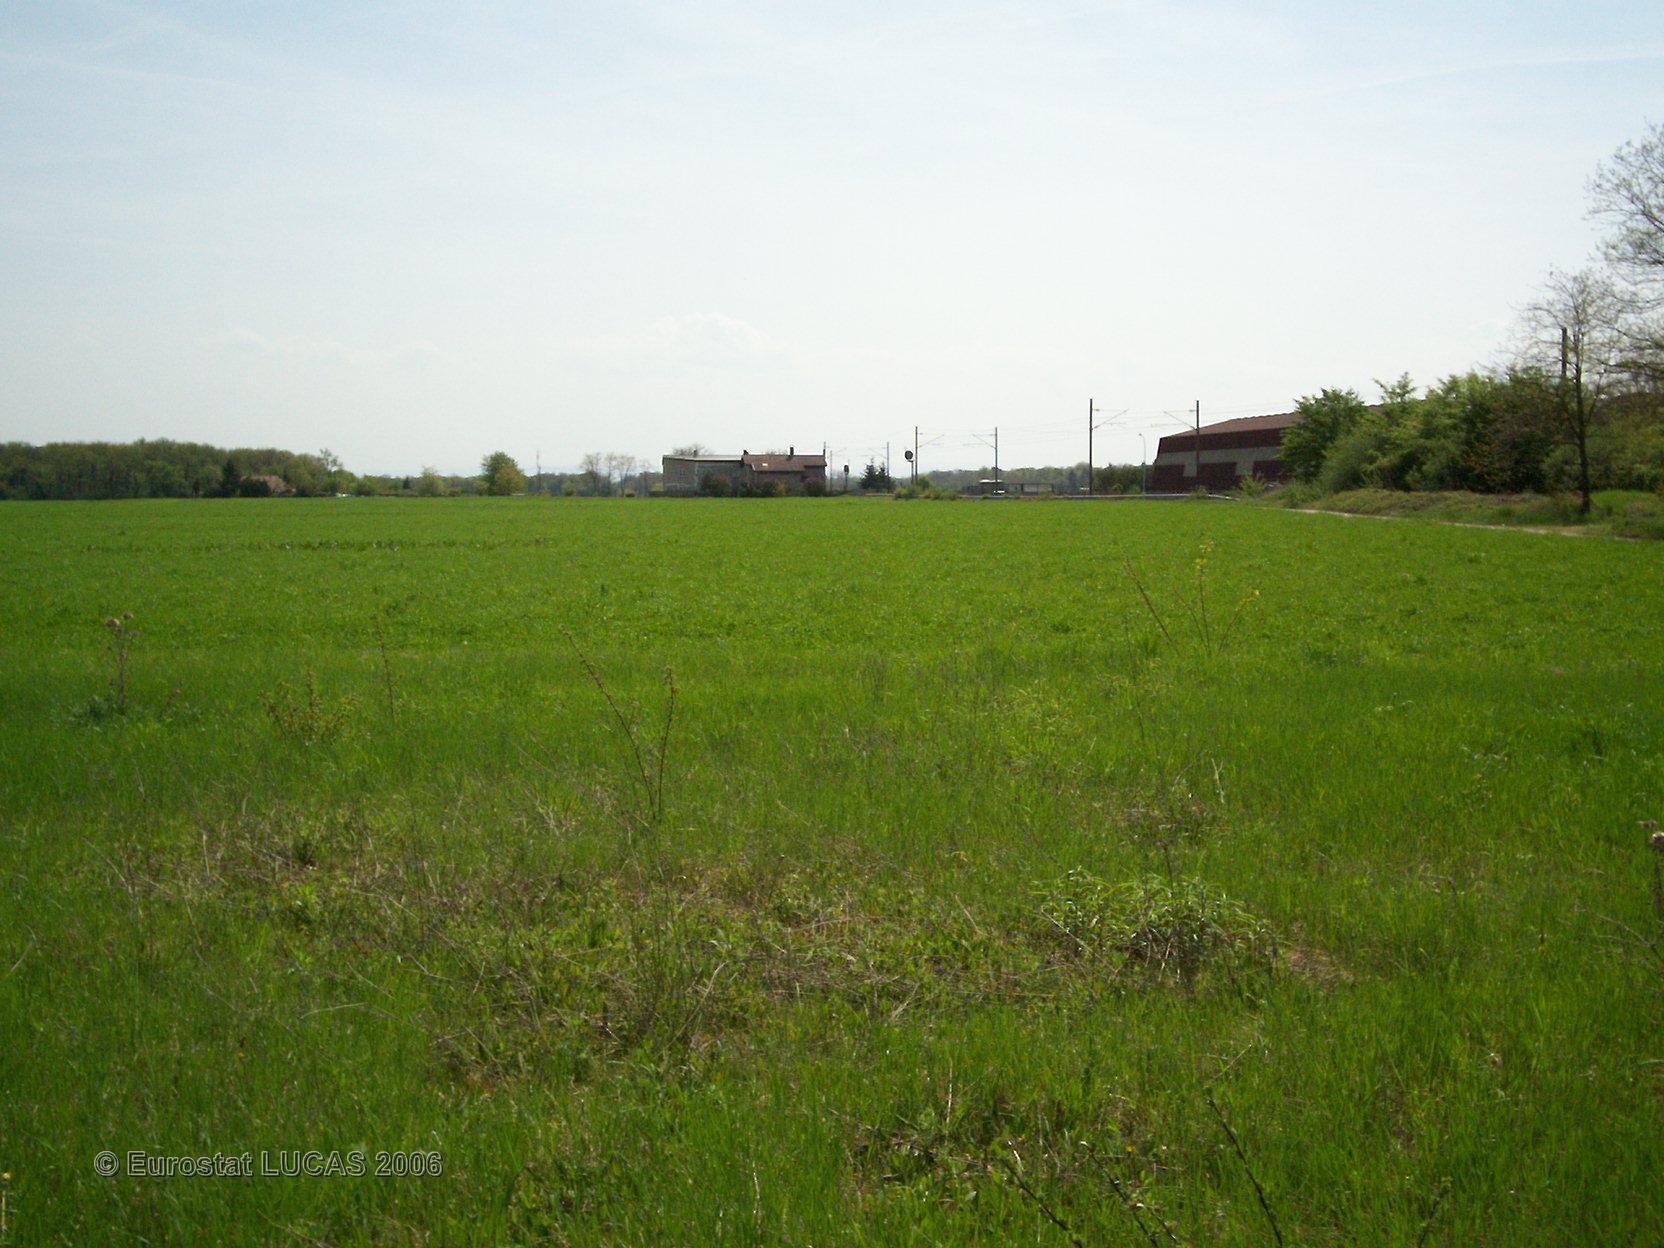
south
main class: Grassland
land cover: Grassland without tree/shrub cover
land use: Fallow land
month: May
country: FR
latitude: 47.7254
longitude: 7.4284
